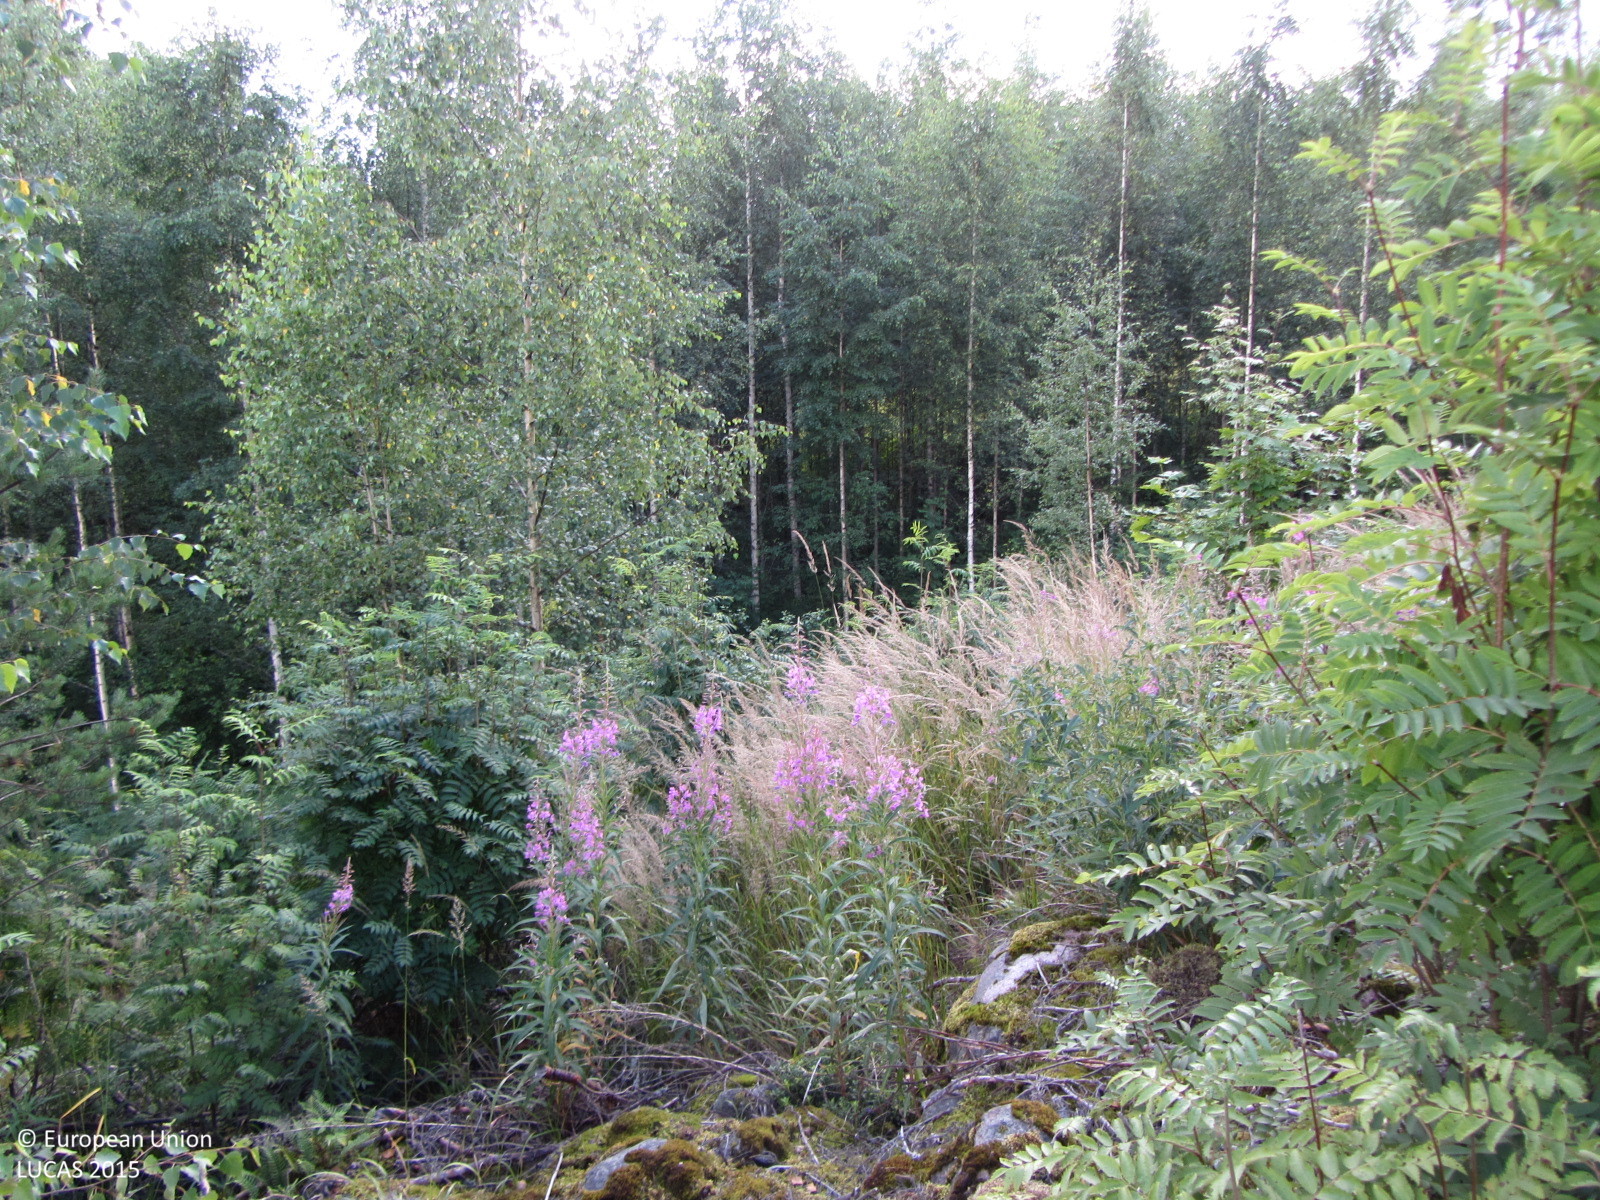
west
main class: Woodland
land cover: Pine dominated mixed woodland
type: boreal forest
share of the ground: 50 - 75 %
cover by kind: broadleaved forest trees 40 %, herbaceous plants 25 %, coniferous forest trees 20 %, lichens and mosses 10 %, consolidated bare surface 5 %
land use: Forestry
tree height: < 5 m
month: July
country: FI
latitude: 60.7283
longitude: 24.6846
